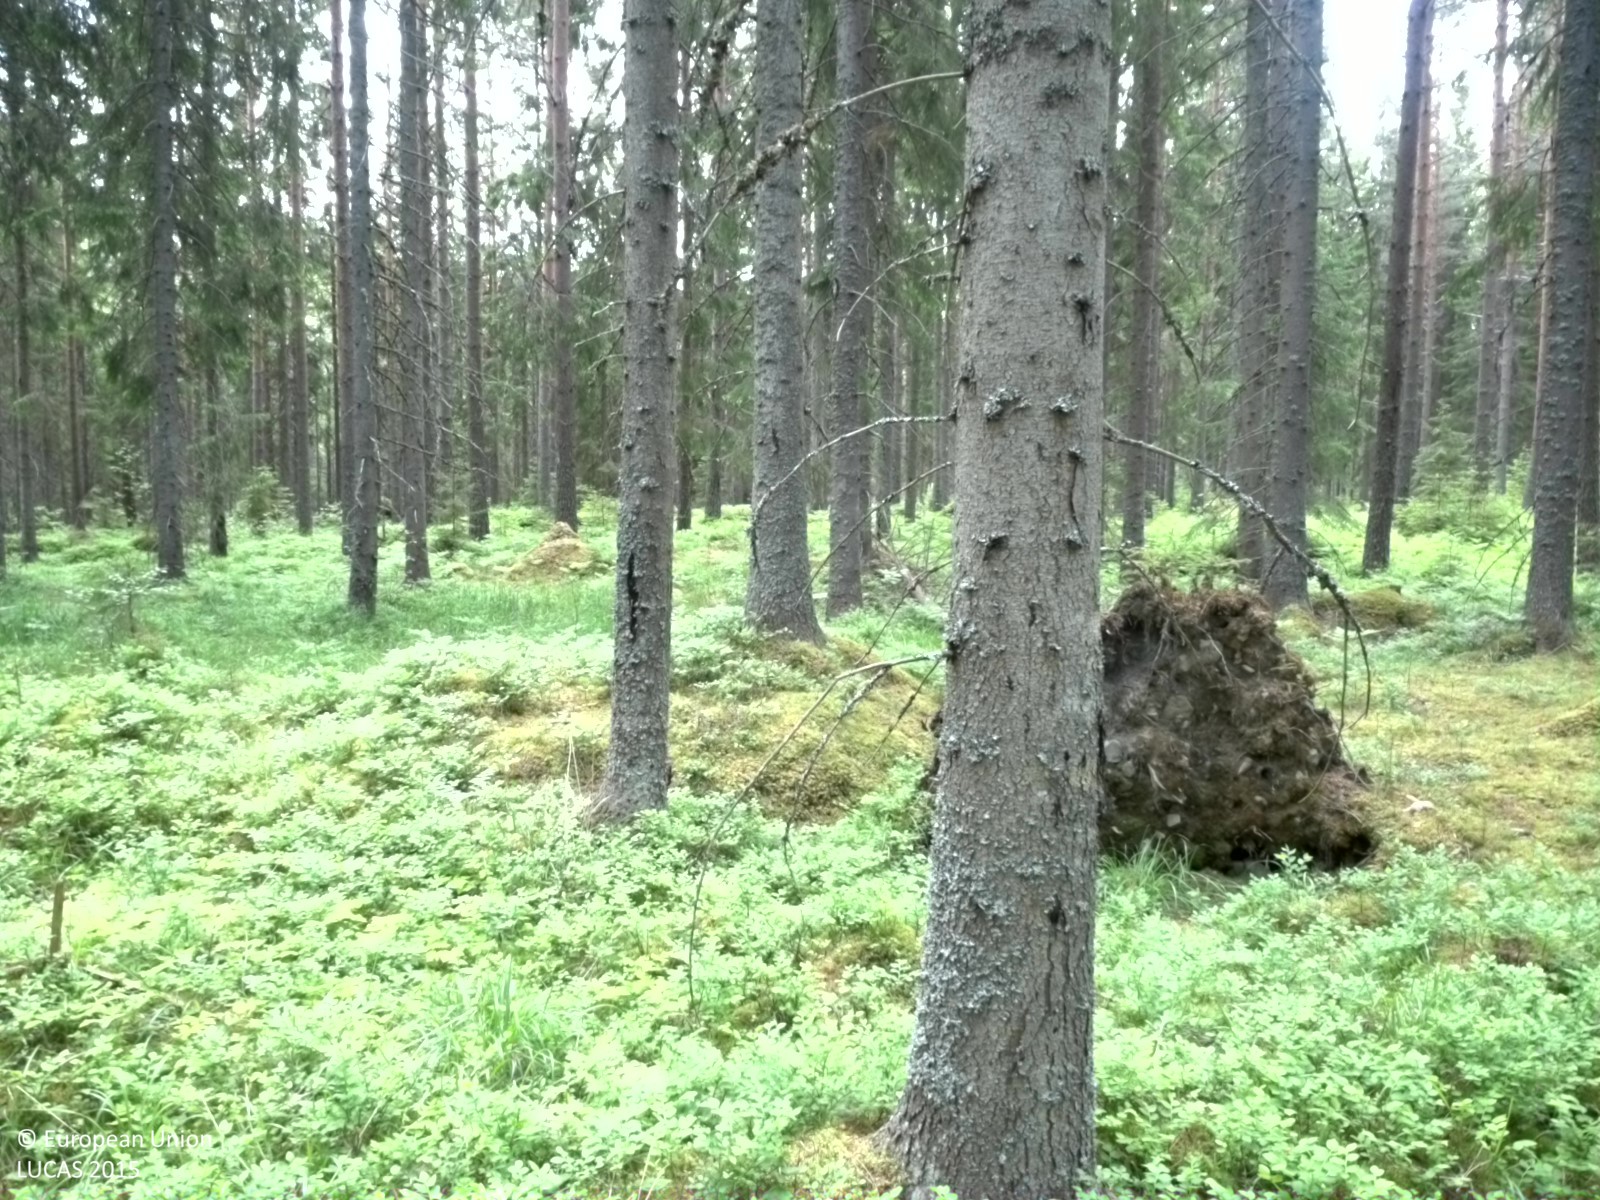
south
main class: Woodland
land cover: Spruce dominated coniferous woodland
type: boreal forest
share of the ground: > 75 %
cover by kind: coniferous forest trees 70 %, shrubs 20 %, broadleaved forest trees 5 %, herbaceous plants 5 %
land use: Forestry
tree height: > 5 m
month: June
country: SE
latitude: 60.3449
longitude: 17.1112
